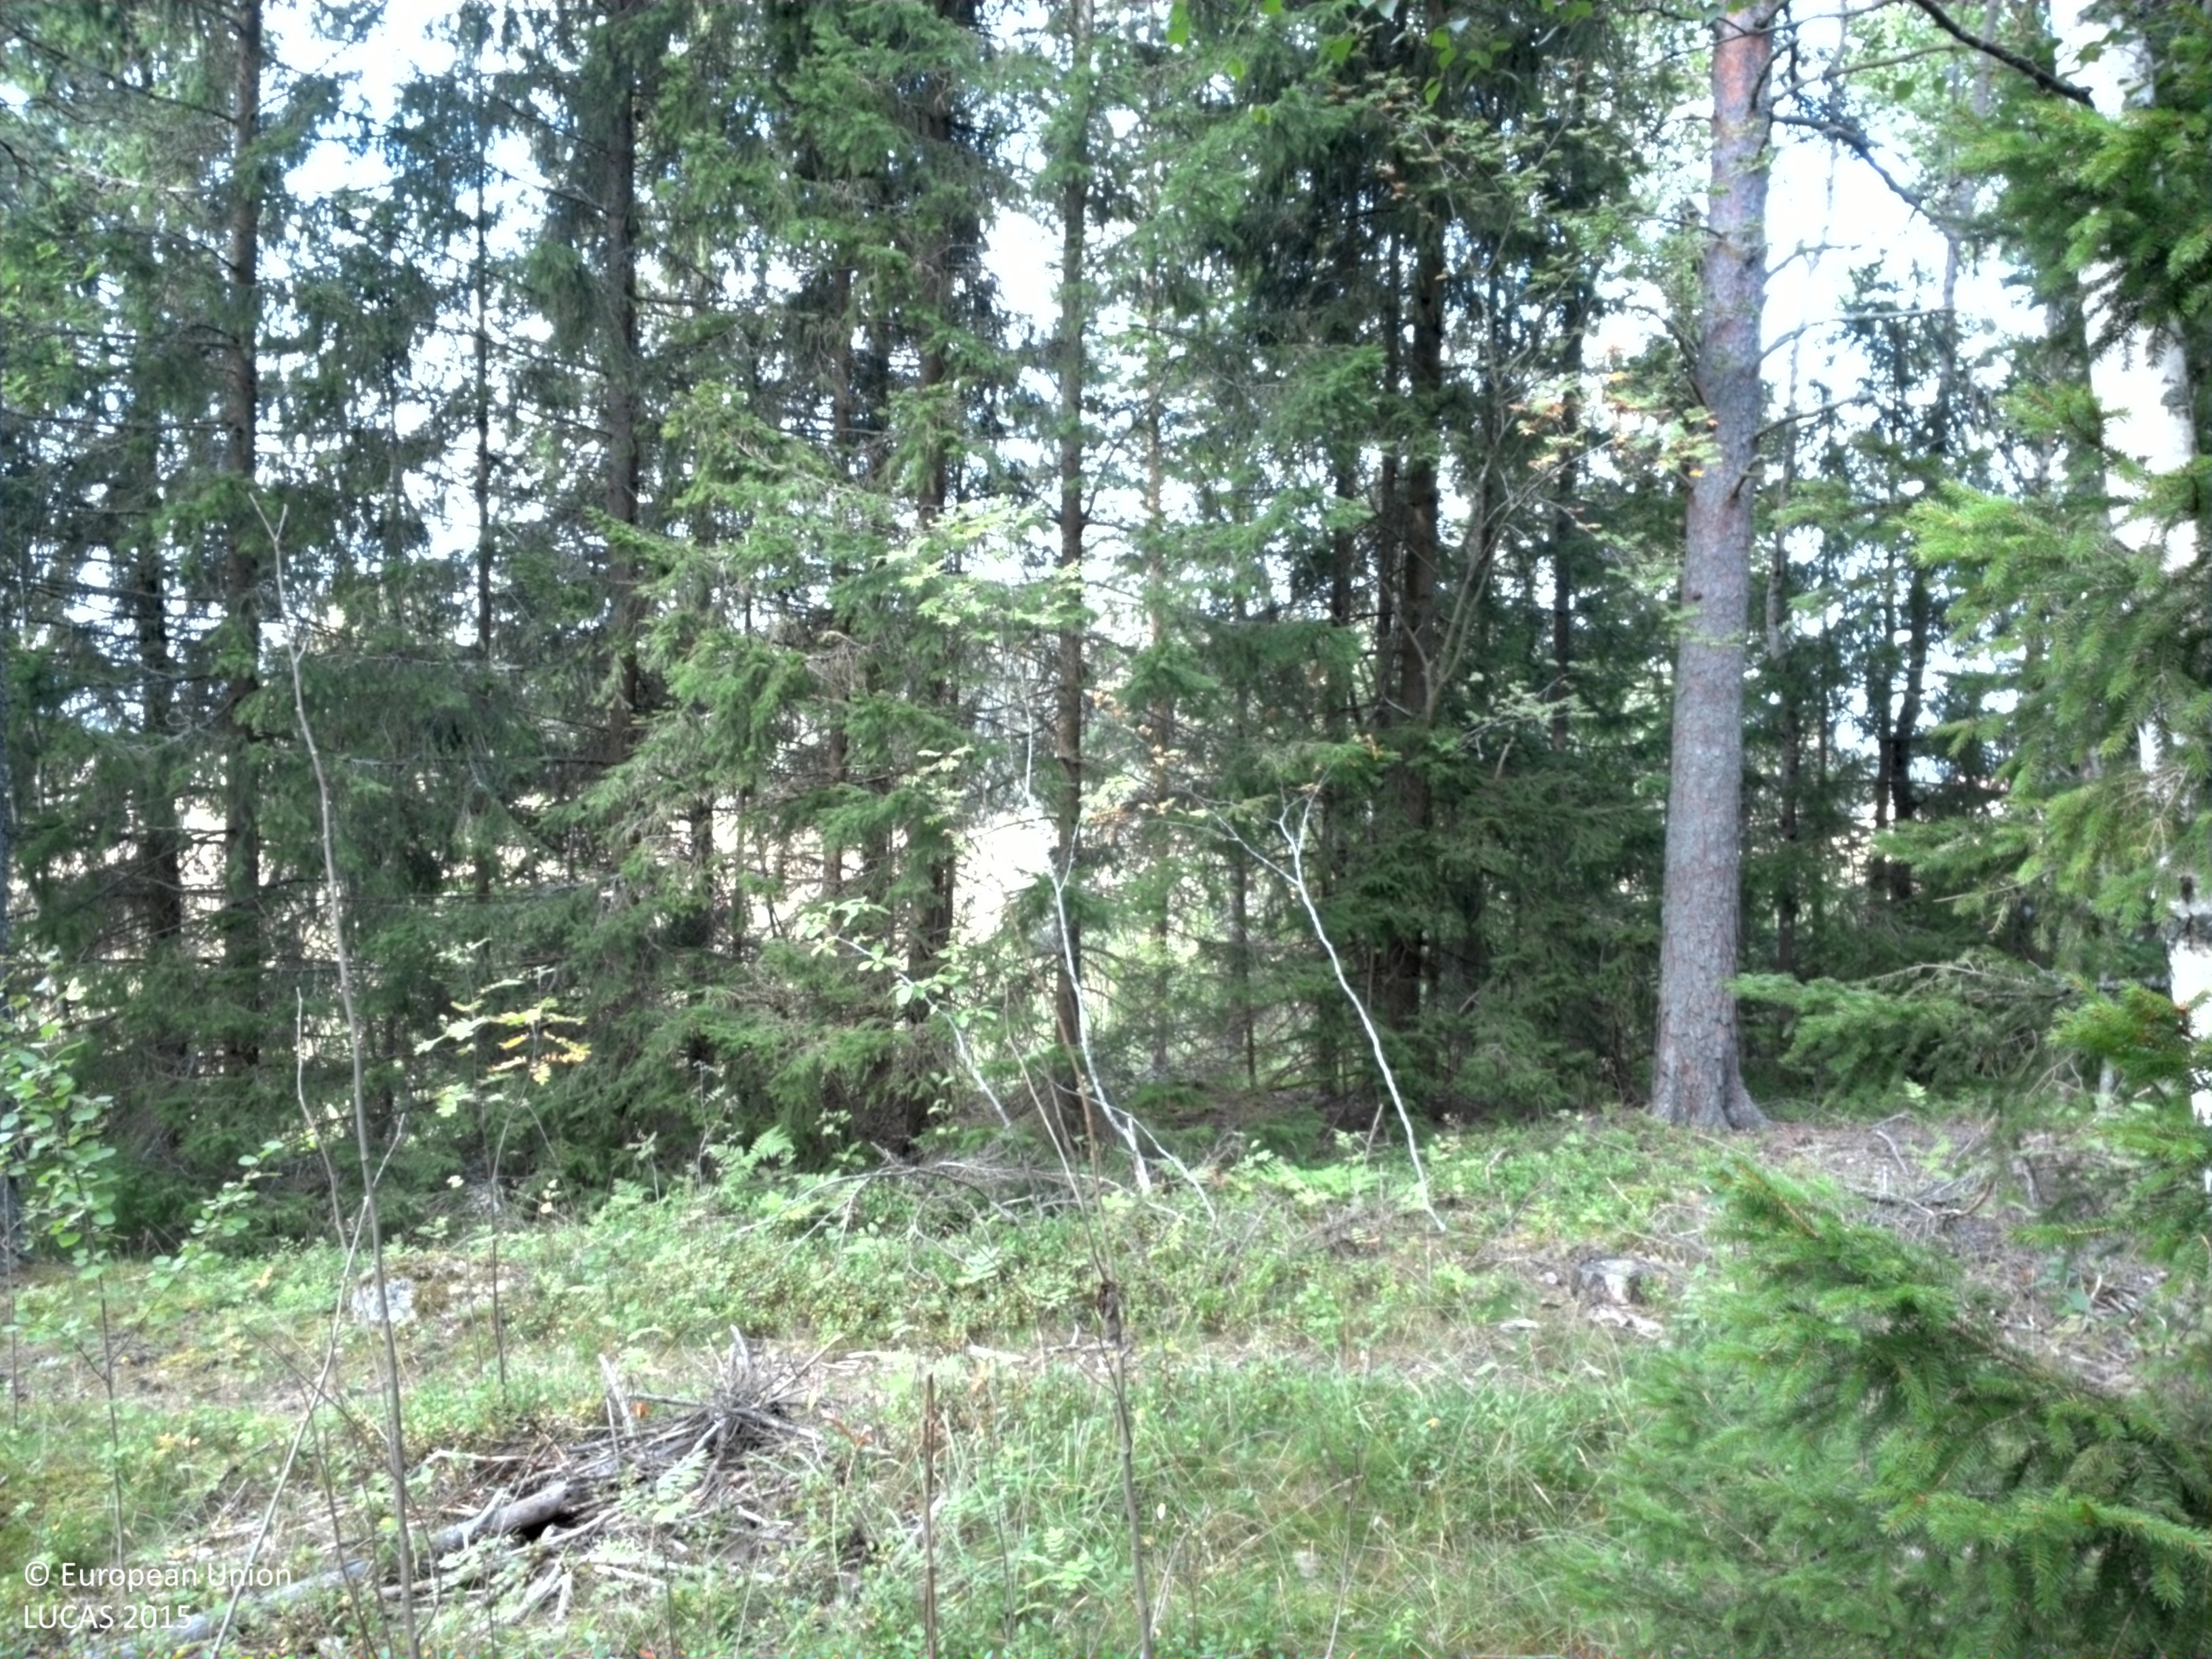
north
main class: Woodland
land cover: Spruce dominated mixed woodland
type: boreal forest
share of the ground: 50 - 75 %
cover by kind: coniferous forest trees 45 %, herbaceous plants 20 %, lichens and mosses 20 %, broadleaved forest trees 15 %
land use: Forestry
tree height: > 5 m
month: August
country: SE
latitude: 60.0090
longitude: 17.6520
